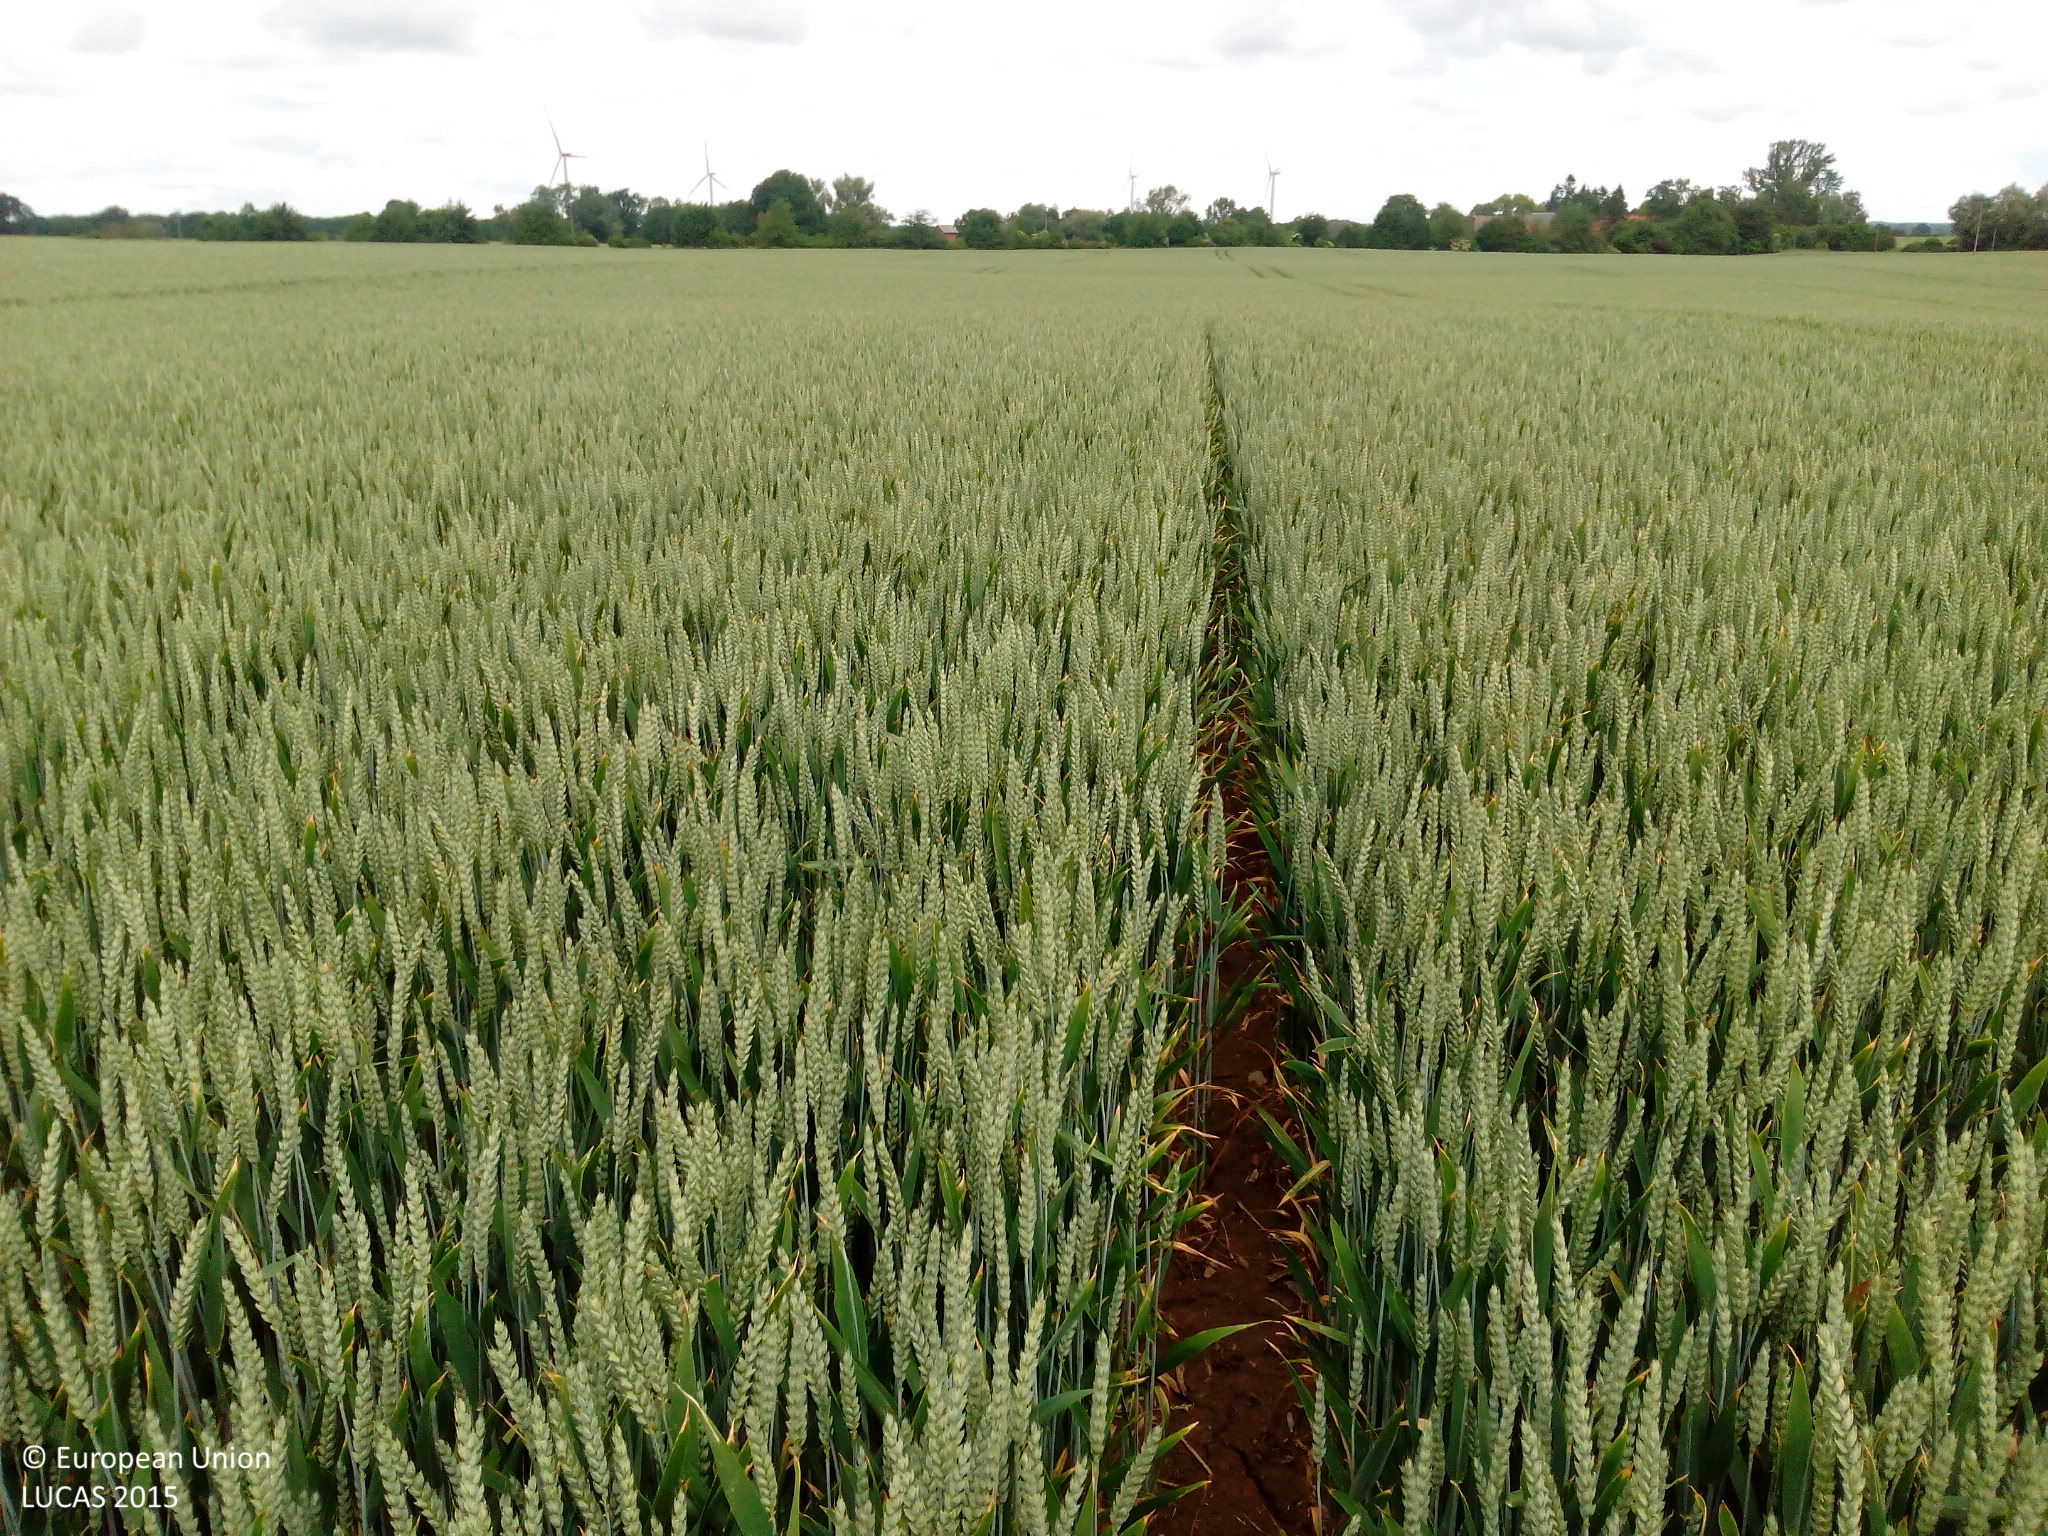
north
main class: Cropland
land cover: Common wheat
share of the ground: > 75 %
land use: Agriculture (excluding fallow land and kitchen gardens)
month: June
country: DE
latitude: 53.8100
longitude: 11.1384
